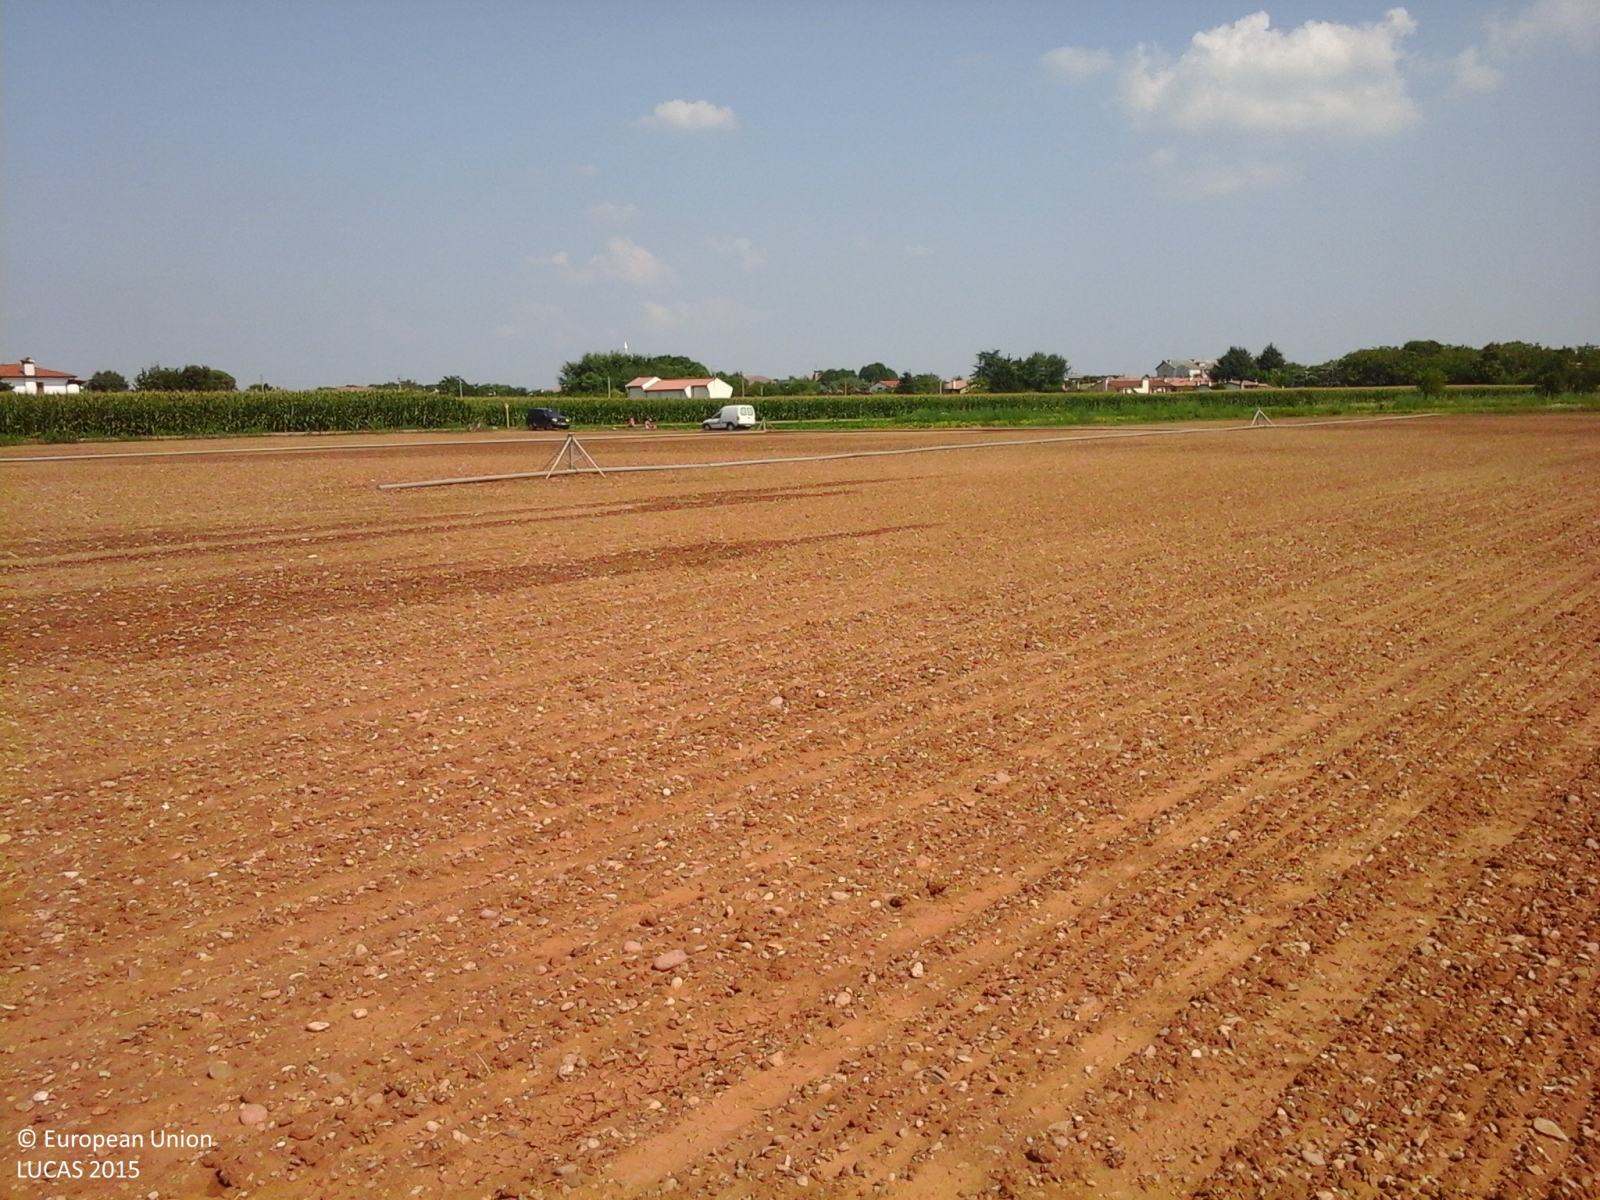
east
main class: Cropland
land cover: Other fresh vegetables
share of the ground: < 10 %
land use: Agriculture (excluding fallow land and kitchen gardens)
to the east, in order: Other fresh vegetables; Ditches and canals; Maize; Tracks; Ditches and canals; Maize
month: July
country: IT
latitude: 45.6974
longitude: 12.2185
